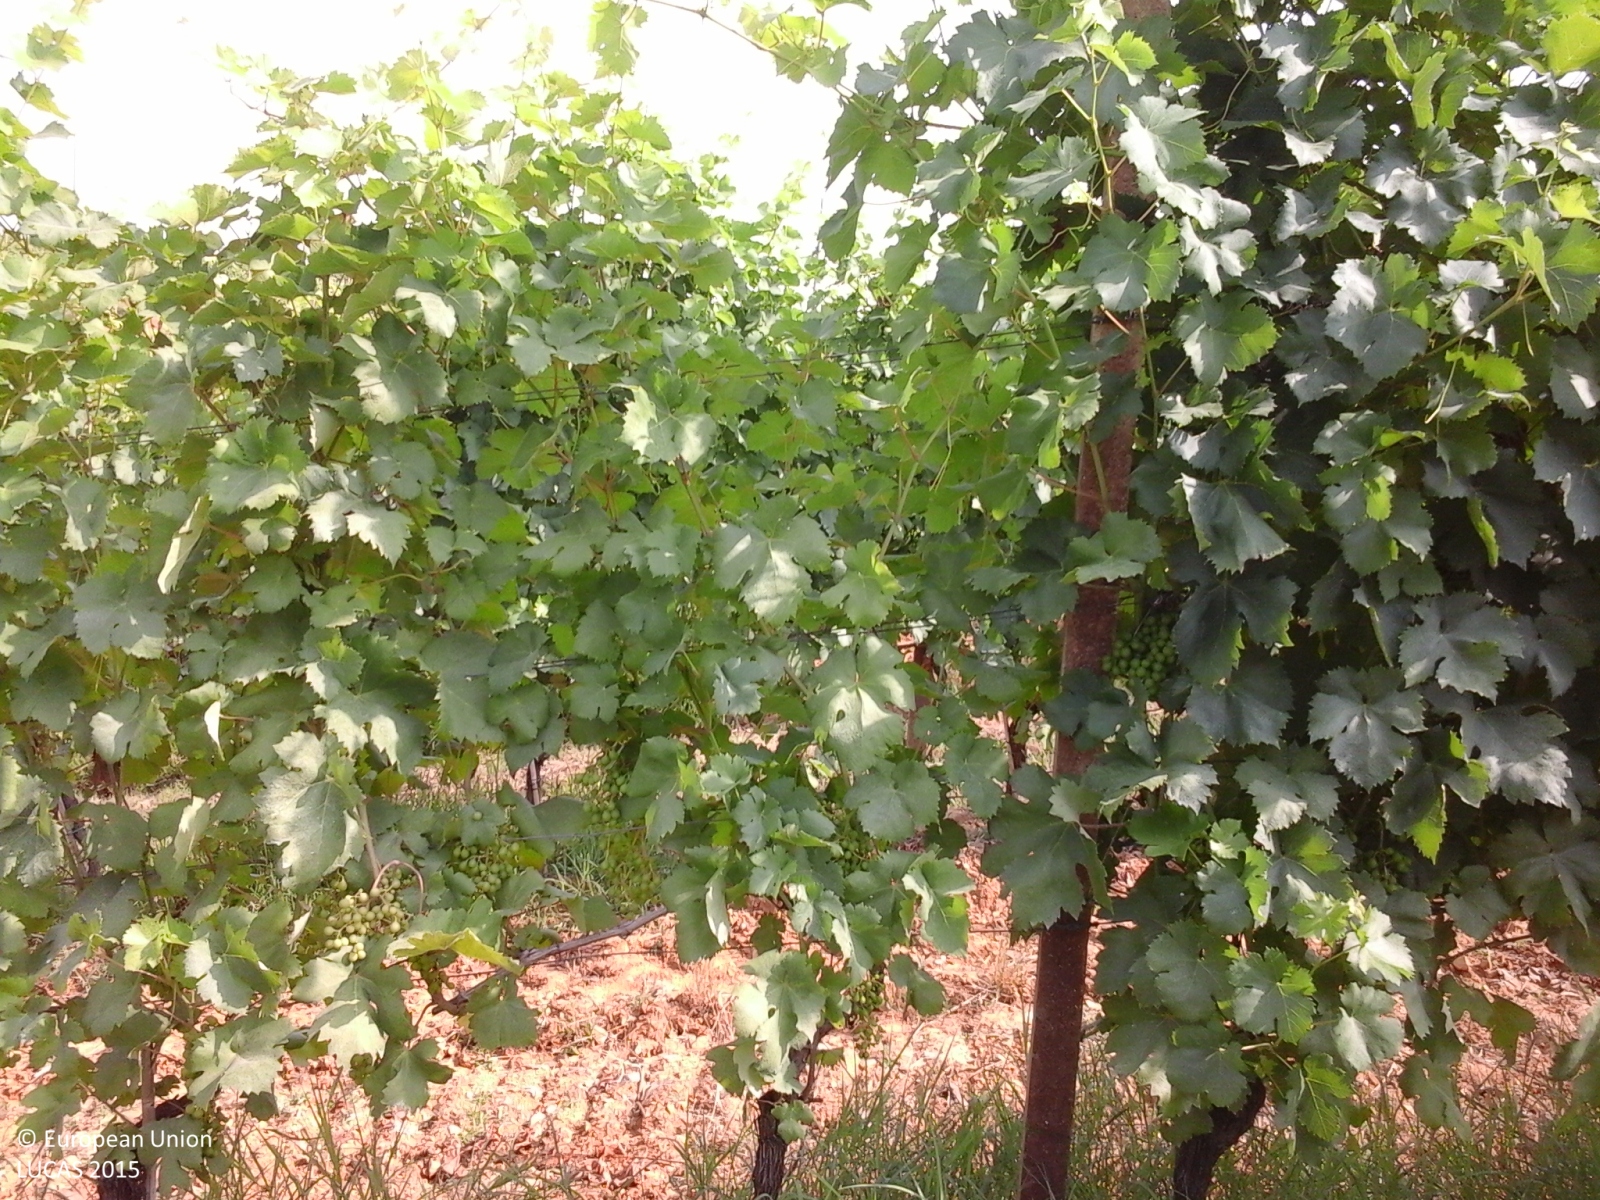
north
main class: Cropland
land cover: Vineyards
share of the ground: 25 - 50 %
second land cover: Grassland without tree/shrub cover
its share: > 75 %
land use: Agriculture (excluding fallow land and kitchen gardens)
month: July
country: IT
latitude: 44.7404
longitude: 8.8027
